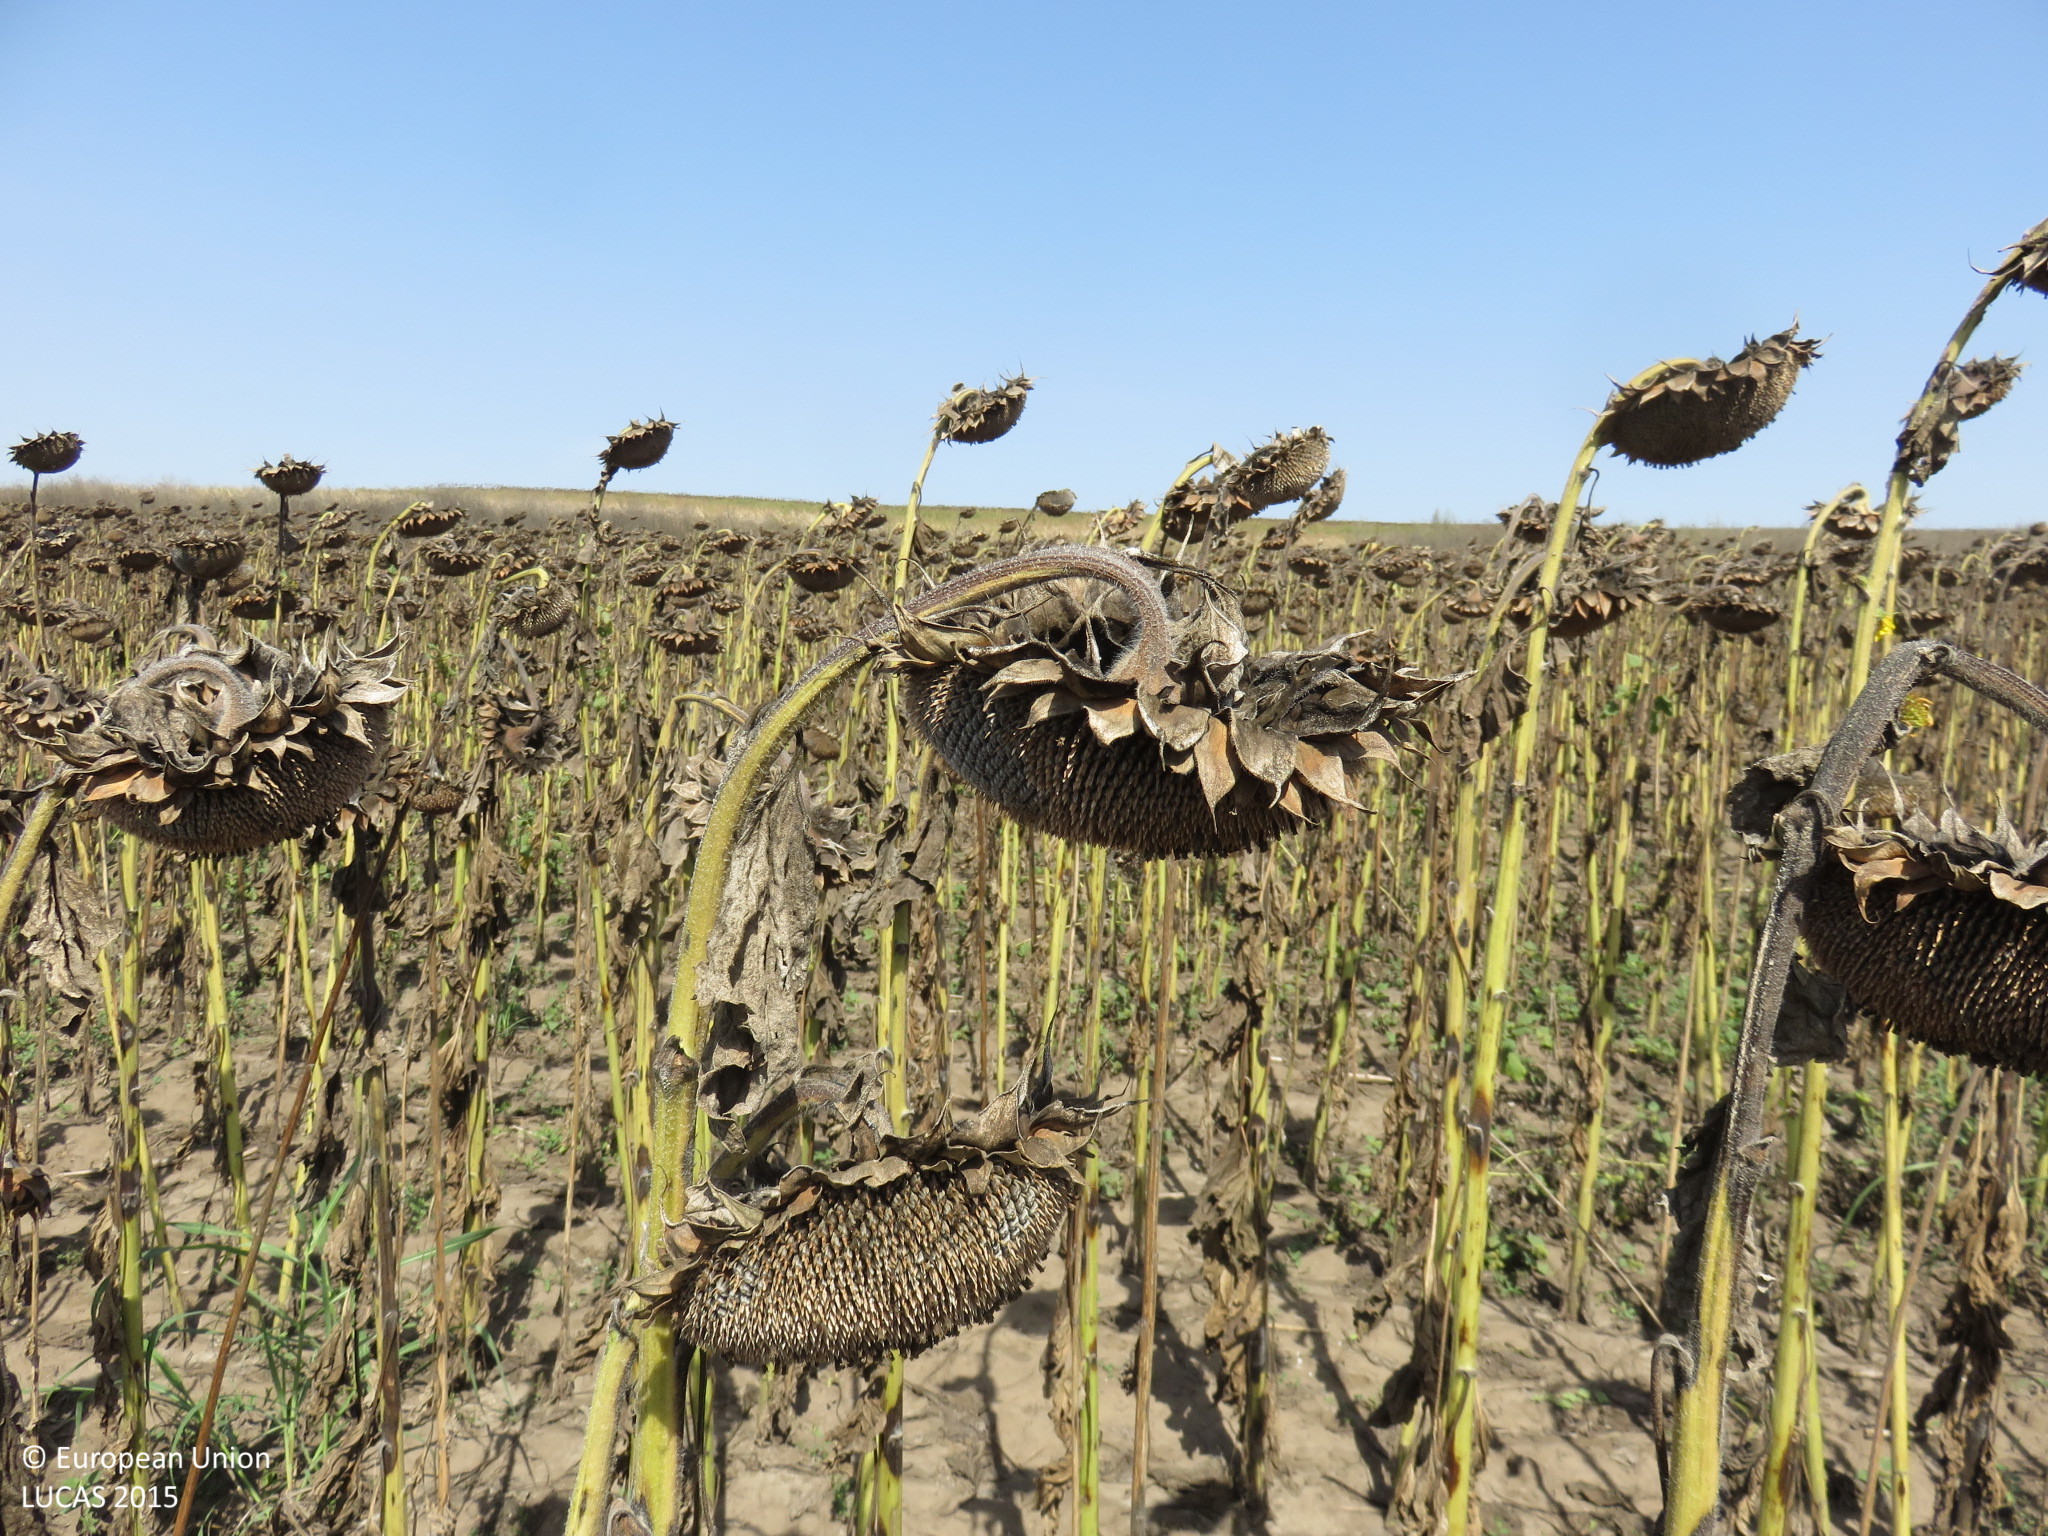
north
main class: Cropland
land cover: Sunflower
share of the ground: > 75 %
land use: Agriculture (excluding fallow land and kitchen gardens)
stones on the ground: < 10 %
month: September
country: BG
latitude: 43.5588
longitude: 24.5345
